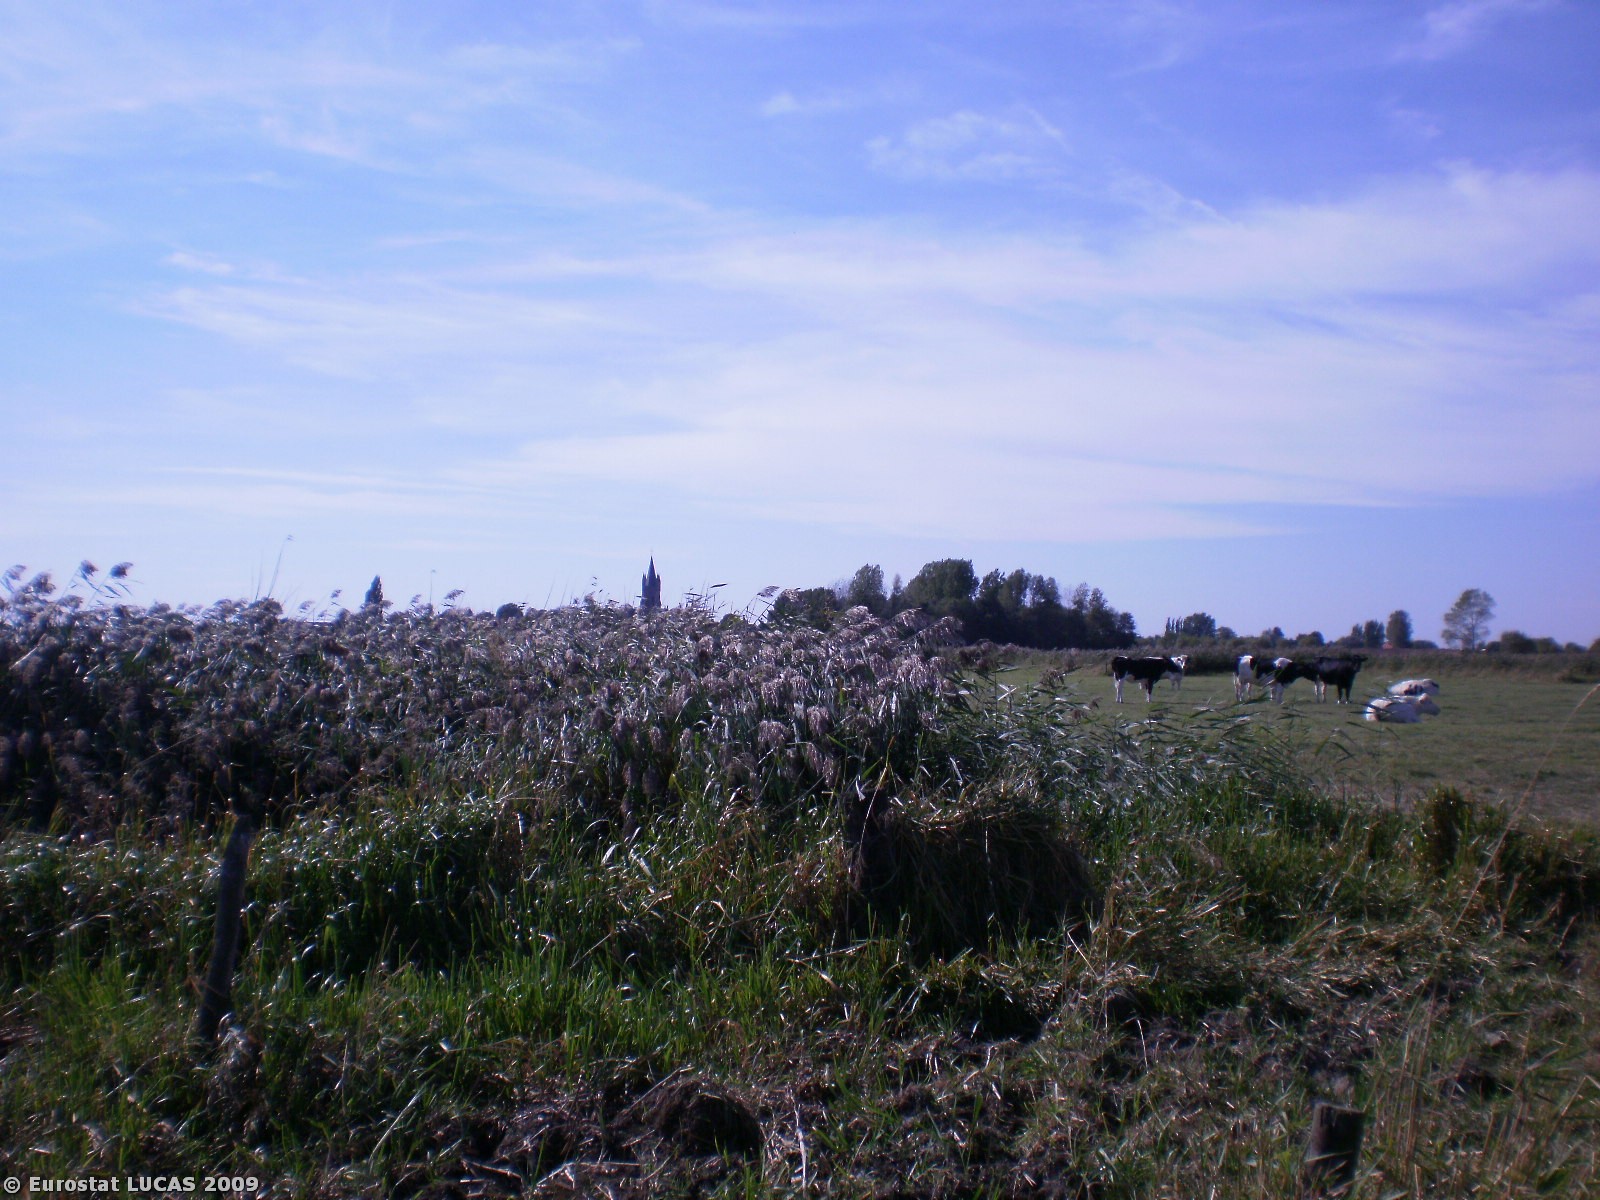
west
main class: Grassland
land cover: Grassland without tree/shrub cover
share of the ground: > 75 %
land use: Agriculture (excluding fallow land and kitchen gardens)
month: September
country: BE
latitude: 50.9494
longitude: 2.8006
